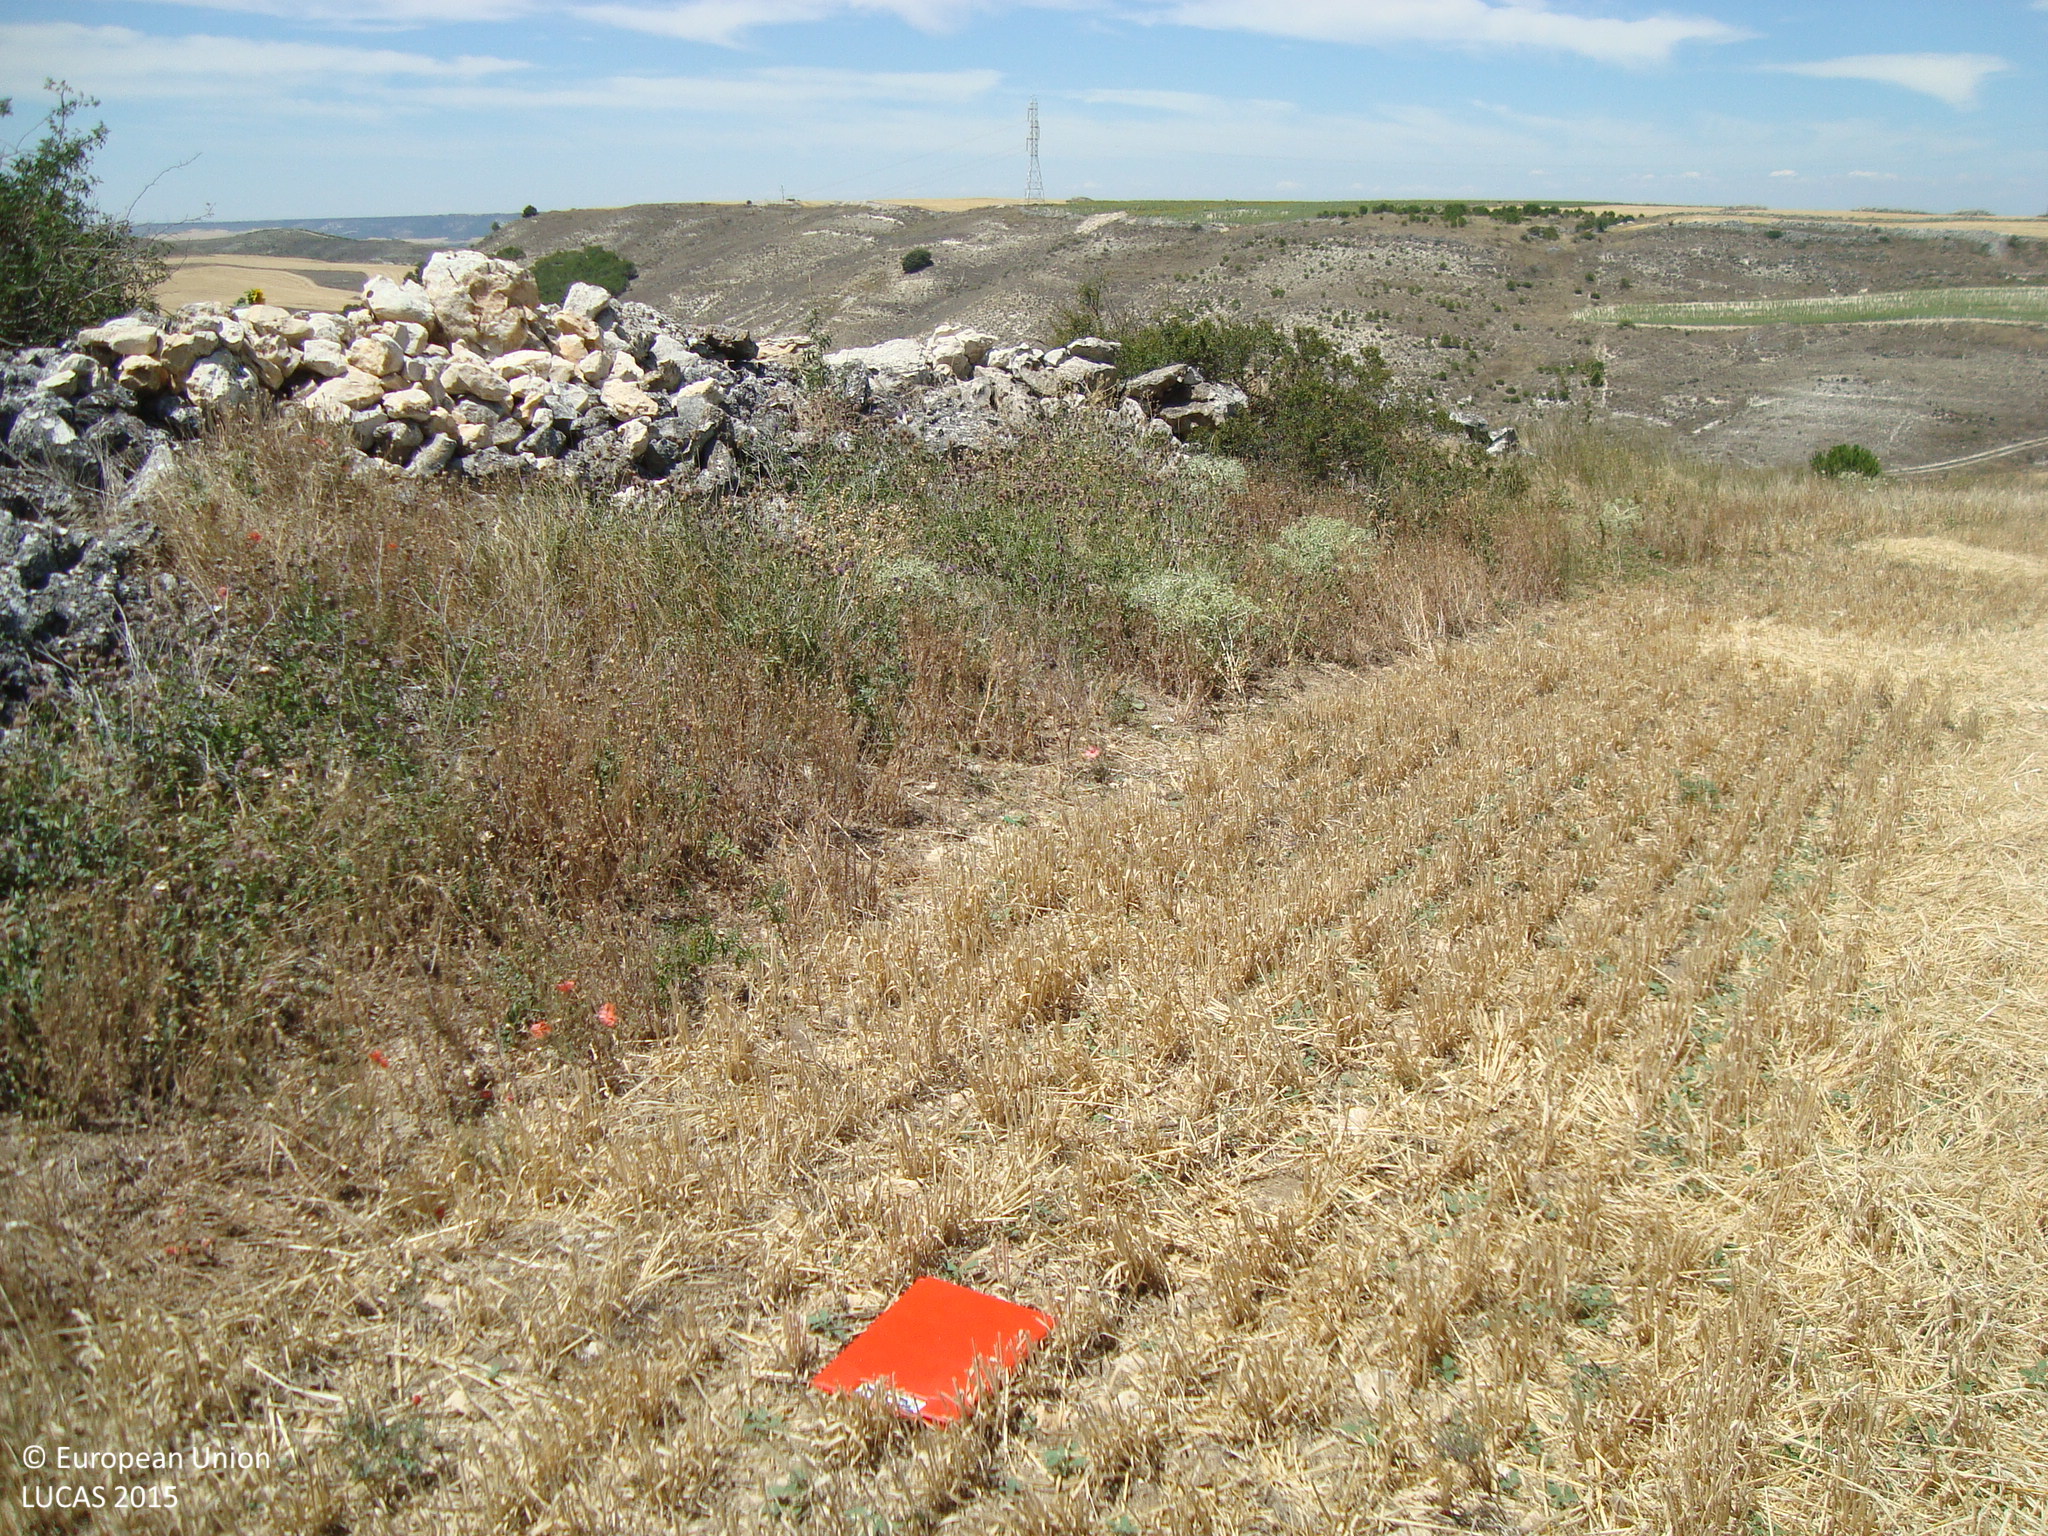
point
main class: Cropland
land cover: Barley
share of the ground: > 75 %
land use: Agriculture (excluding fallow land and kitchen gardens)
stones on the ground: 25 - 50 %
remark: Harvested field
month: July
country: ES
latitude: 42.0378
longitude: -4.1616
